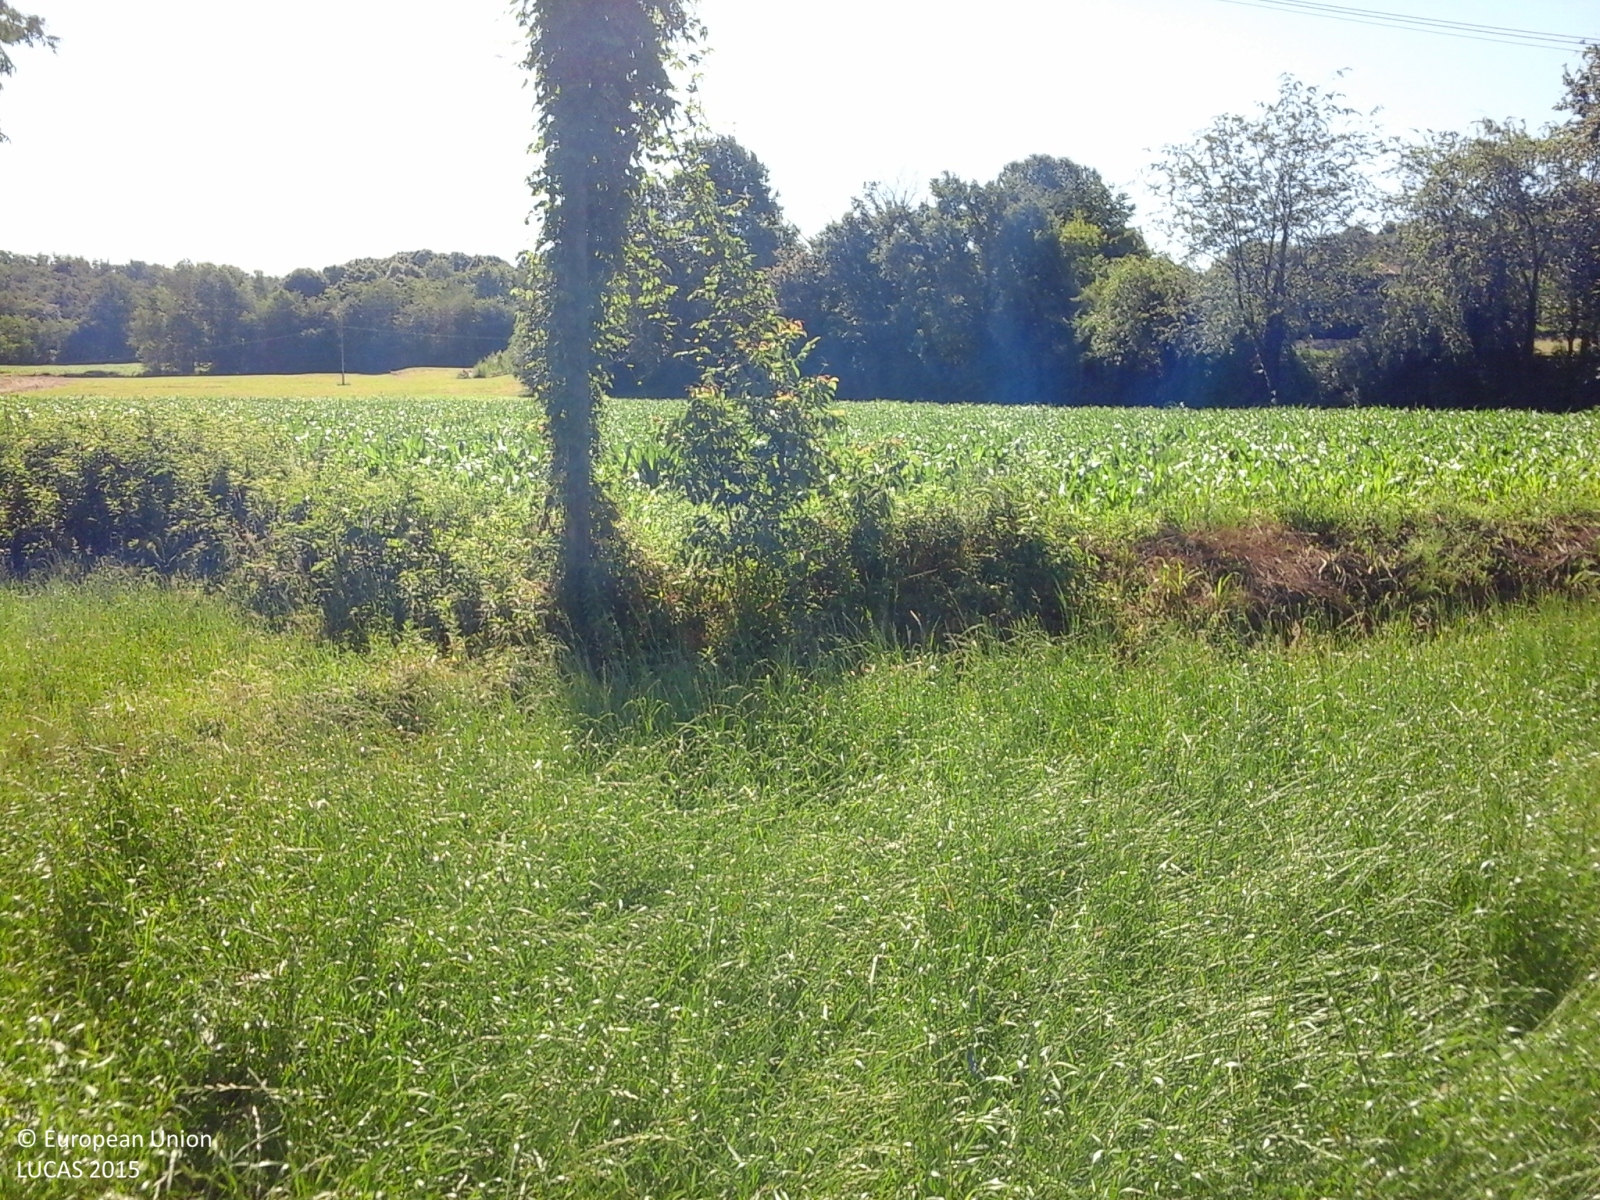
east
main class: Grassland
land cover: Grassland without tree/shrub cover
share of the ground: > 75 %
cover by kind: herbaceous plants 100 %
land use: Agriculture (excluding fallow land and kitchen gardens)
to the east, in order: Grassland without tree/shrub cover; Tracks; Electric lines; Grassland without tree/shrub cover; Grass margins; Maize; Electric lines; Maize; Grassland without tree/shrub cover; Electric lines; Grass margins
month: June
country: IT
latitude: 45.7838
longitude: 8.6258
